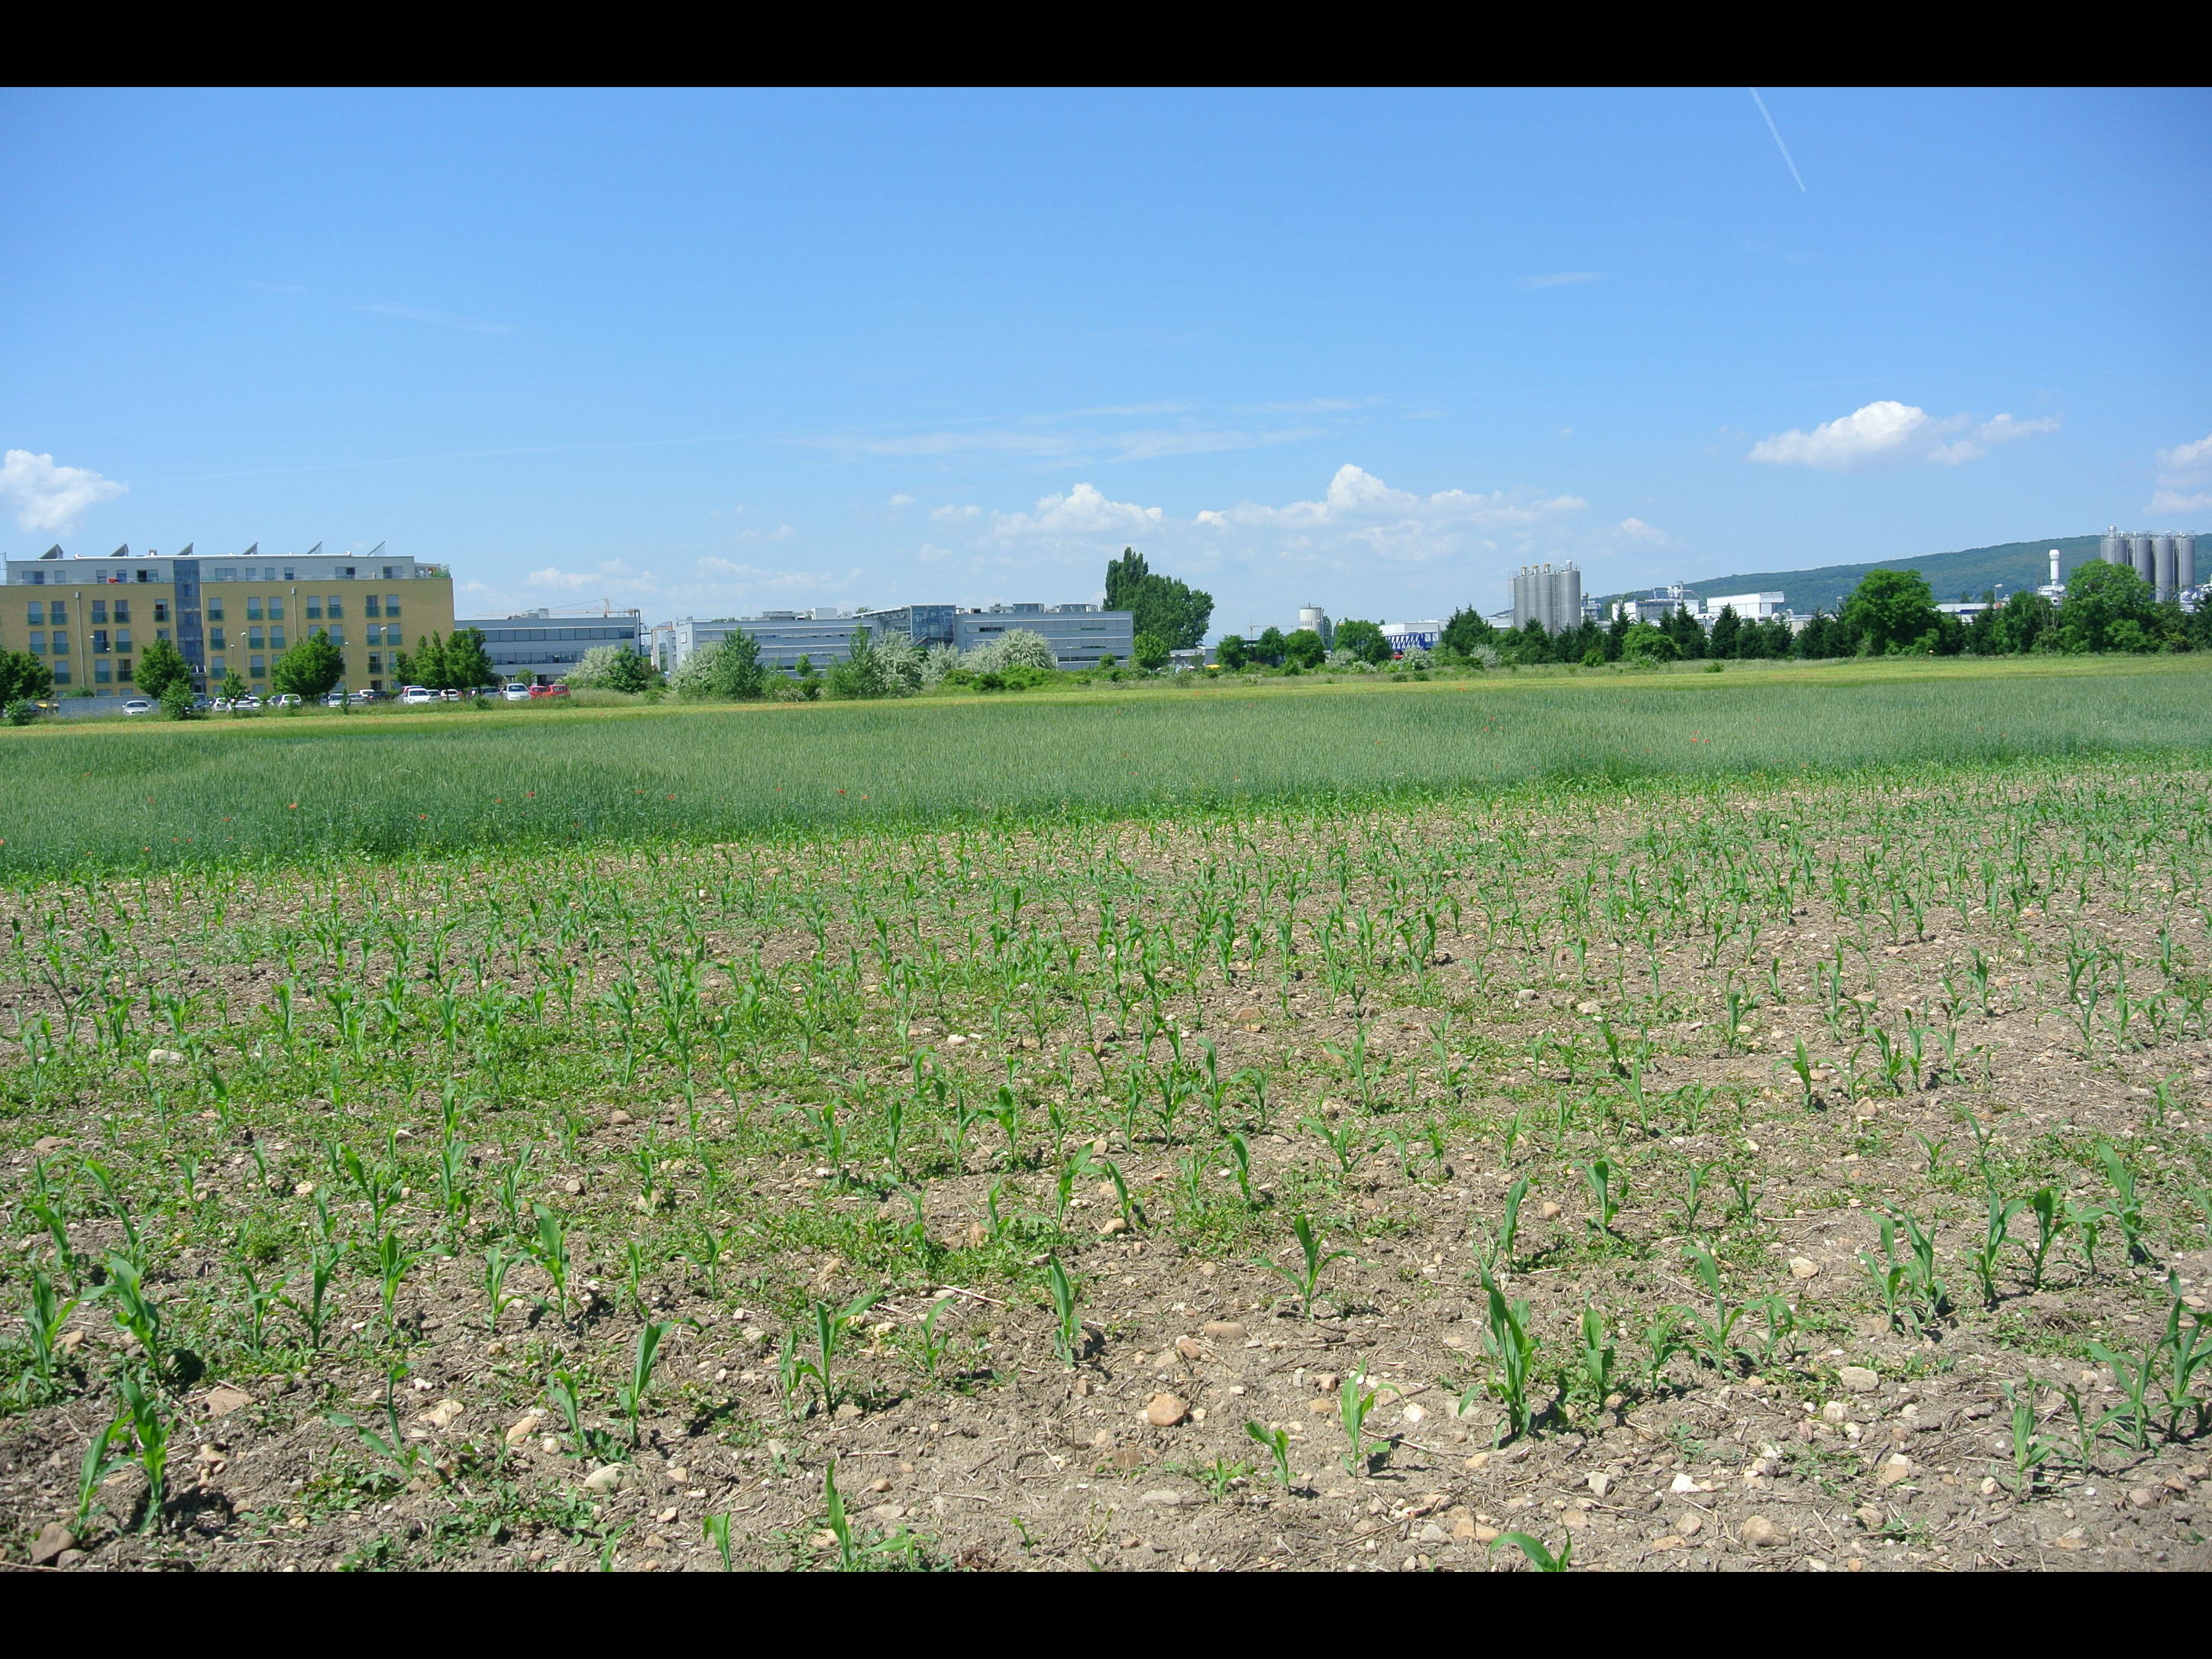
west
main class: Cropland
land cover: Maize
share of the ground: 10 - 25 %
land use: Agriculture (excluding fallow land and kitchen gardens)
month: June
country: AT
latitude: 47.8309
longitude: 16.5374
